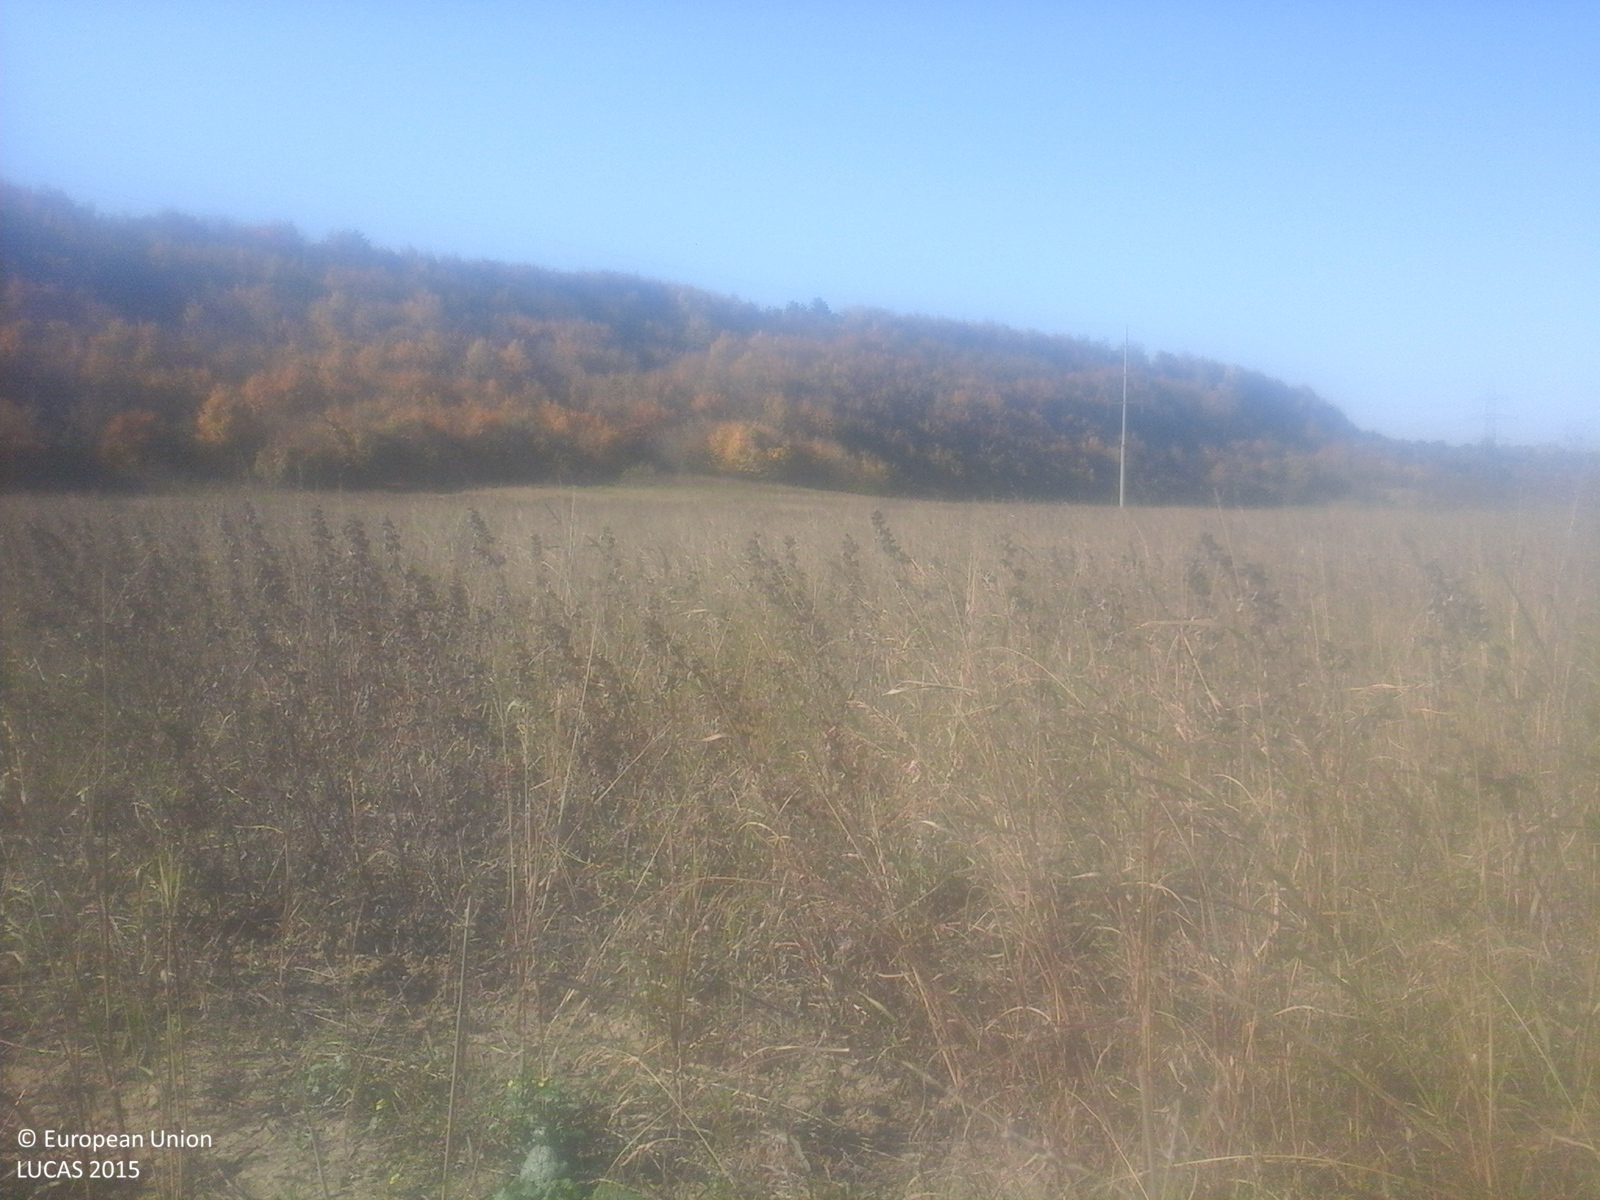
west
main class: Grassland
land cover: Spontaneously vegetated surfaces
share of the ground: > 75 %
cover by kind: herbaceous plants 100 %
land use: Fallow land
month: October
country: RO
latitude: 45.8826
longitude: 27.0892
